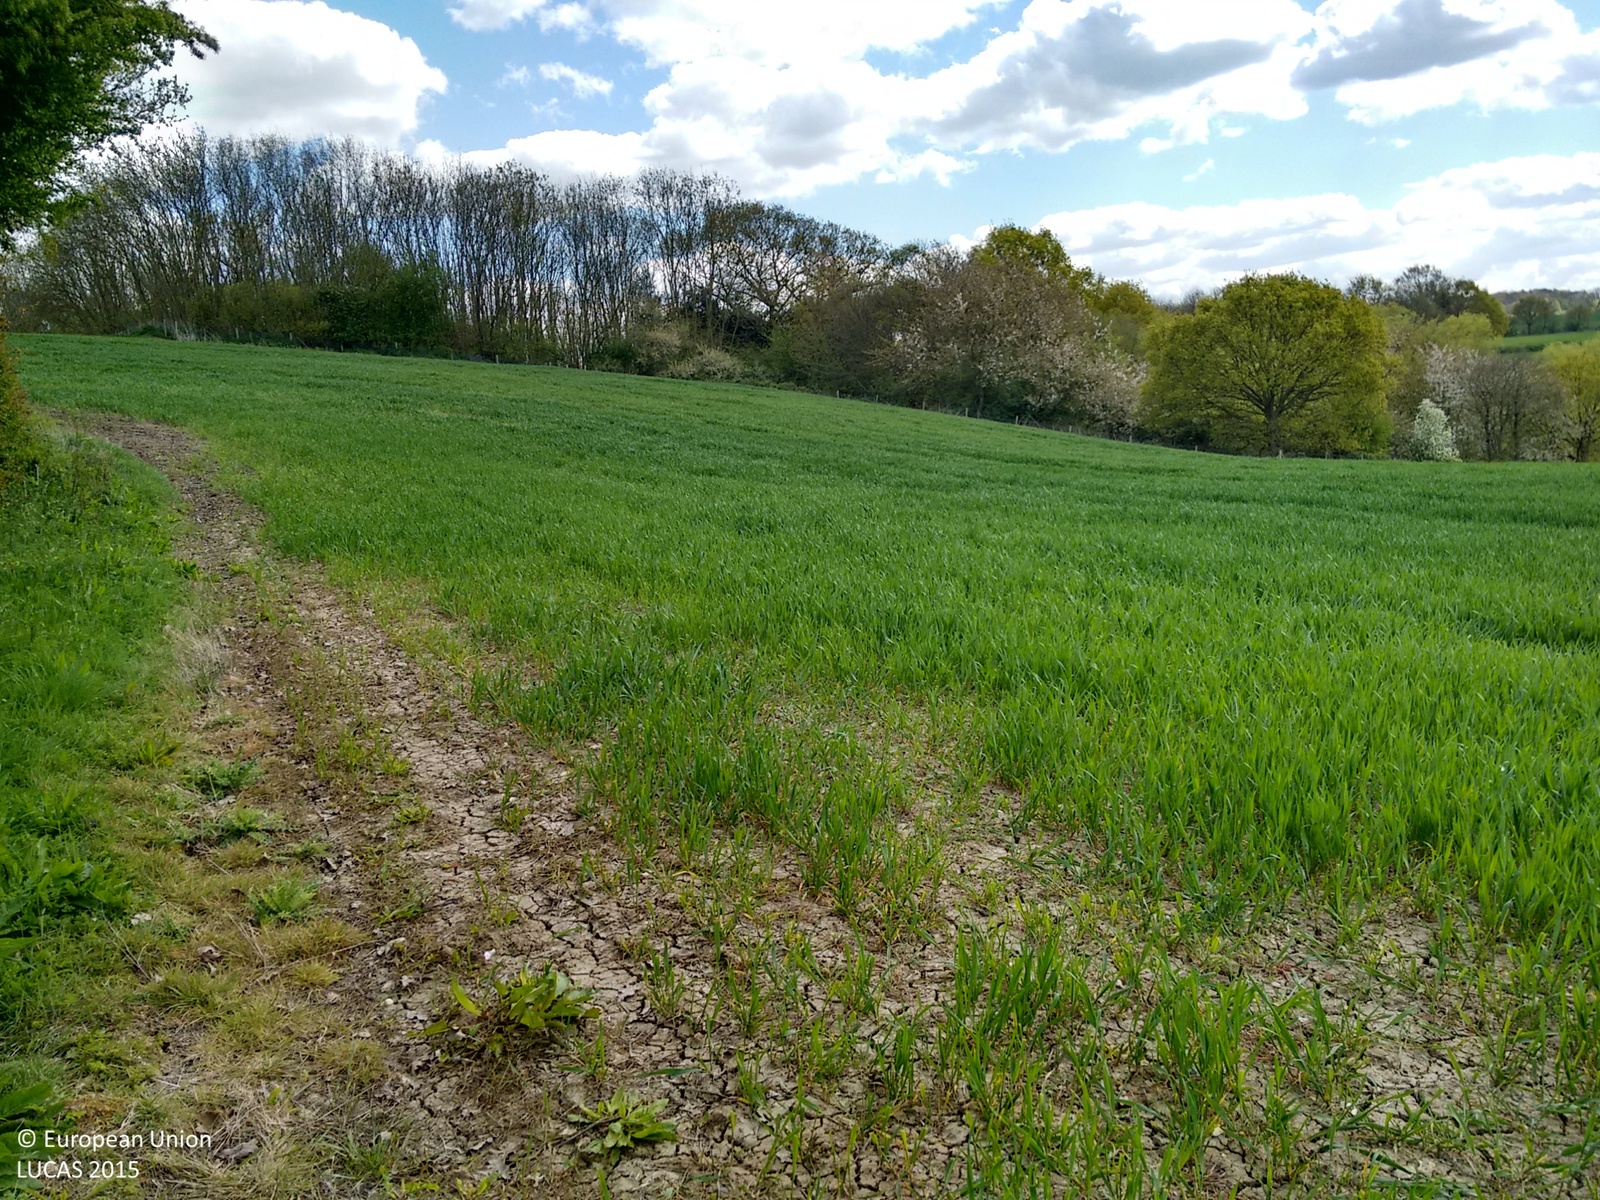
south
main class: Cropland
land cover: Common wheat
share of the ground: > 75 %
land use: Agriculture (excluding fallow land and kitchen gardens)
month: April
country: GB
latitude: 51.3587
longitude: 0.6822
